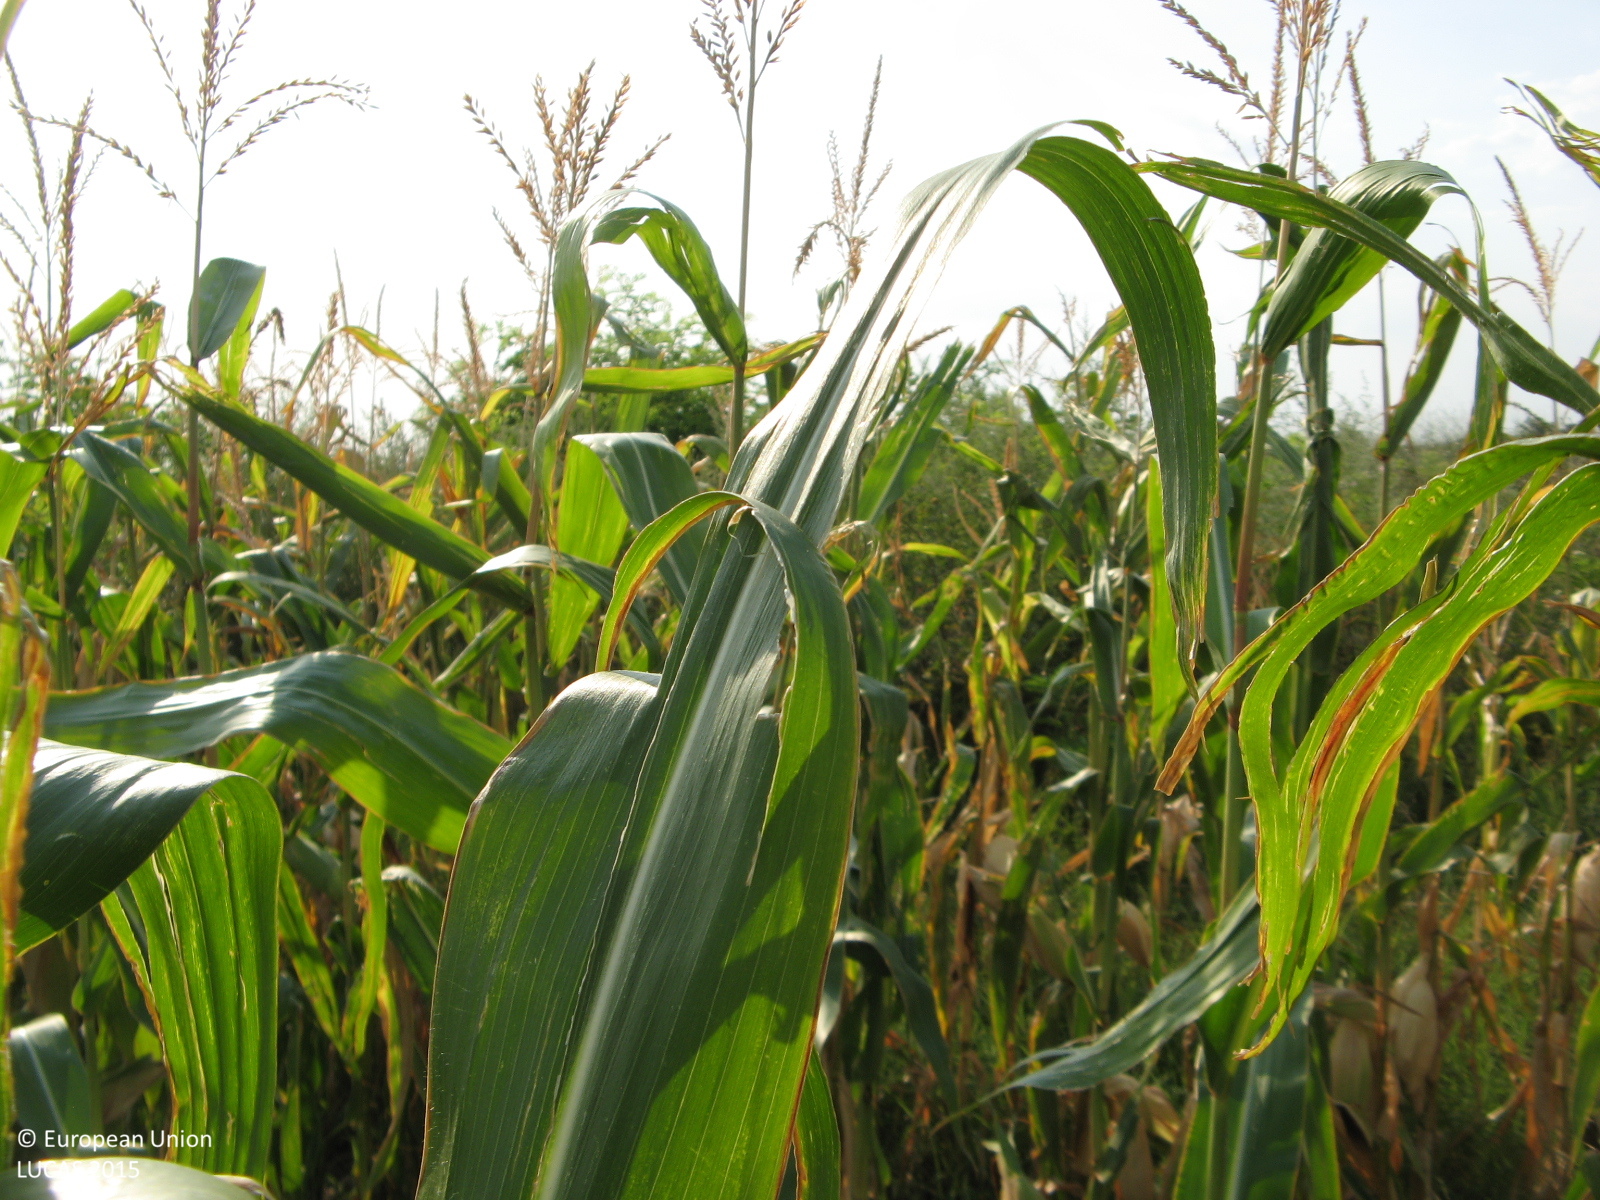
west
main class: Cropland
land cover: Maize
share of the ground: > 75 %
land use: Agriculture (excluding fallow land and kitchen gardens)
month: August
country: BG
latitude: 43.5611
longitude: 25.2675
